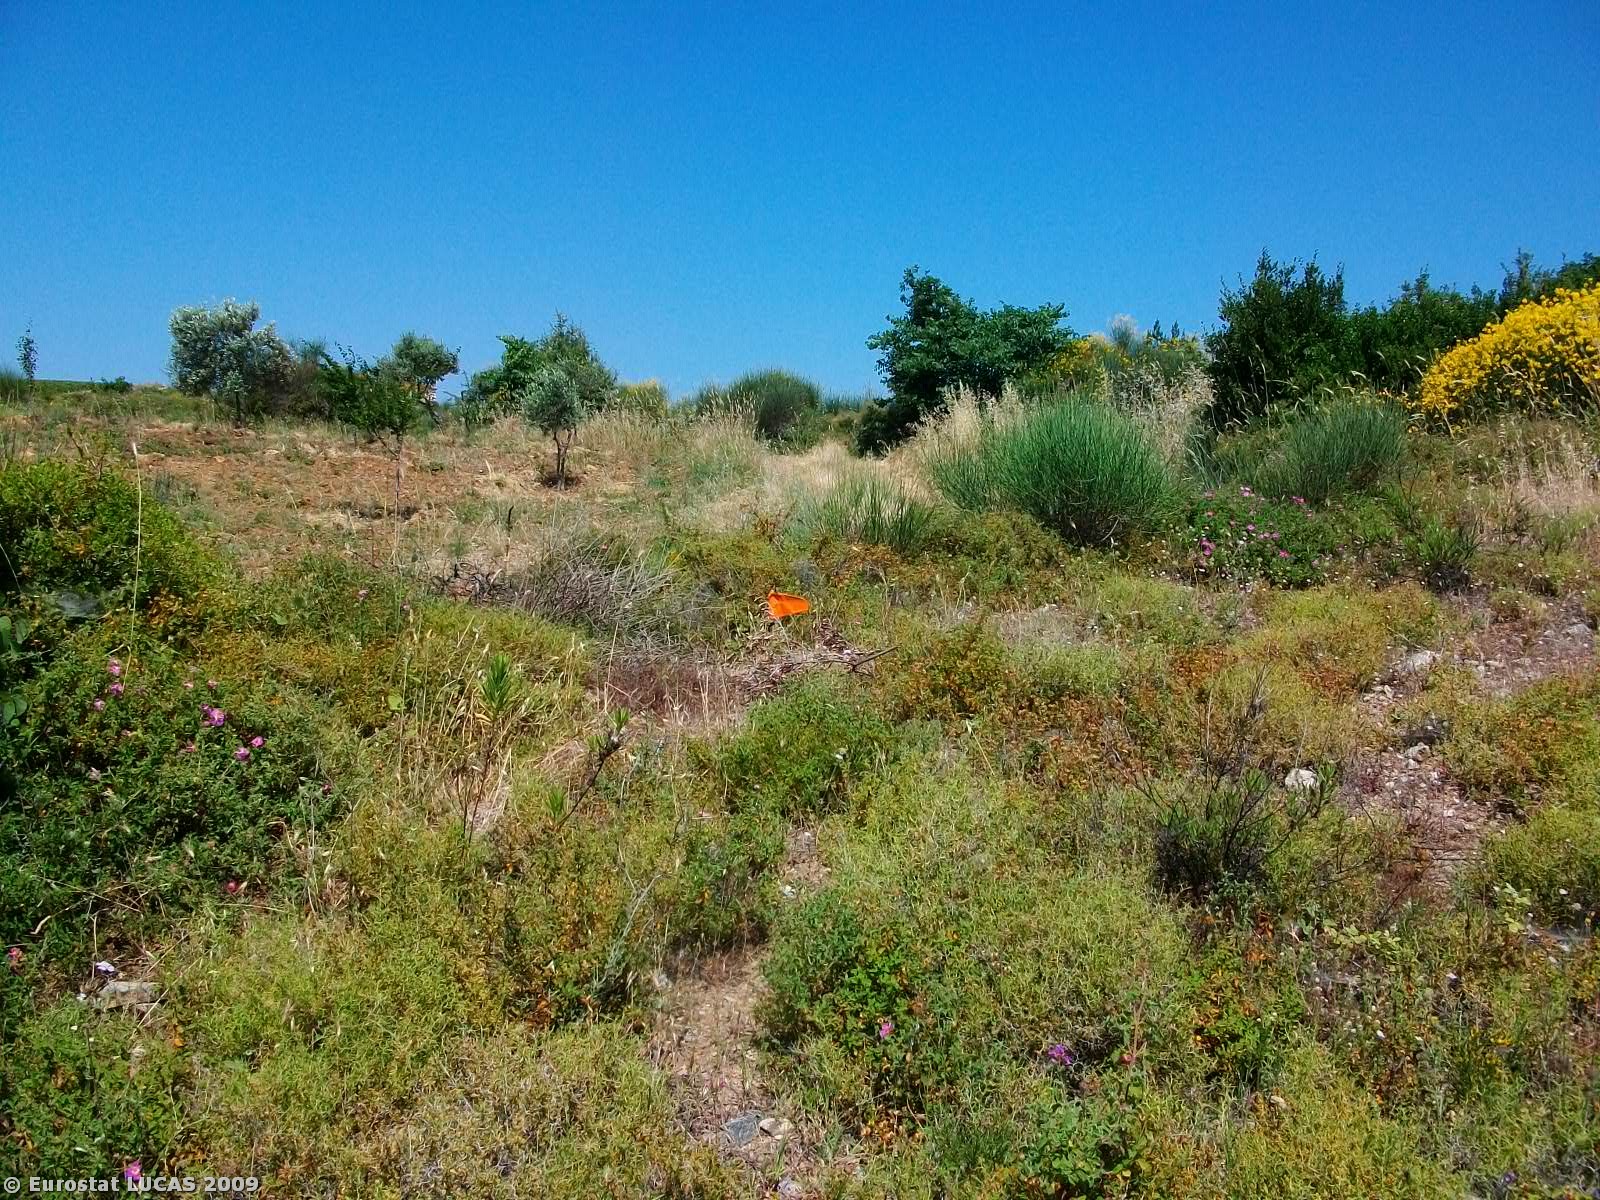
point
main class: Shrubland
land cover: Shrubland without tree cover
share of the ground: > 75 %
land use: Unused
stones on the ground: > 50 %
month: June
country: GR
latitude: 39.2203
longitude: 23.2316
